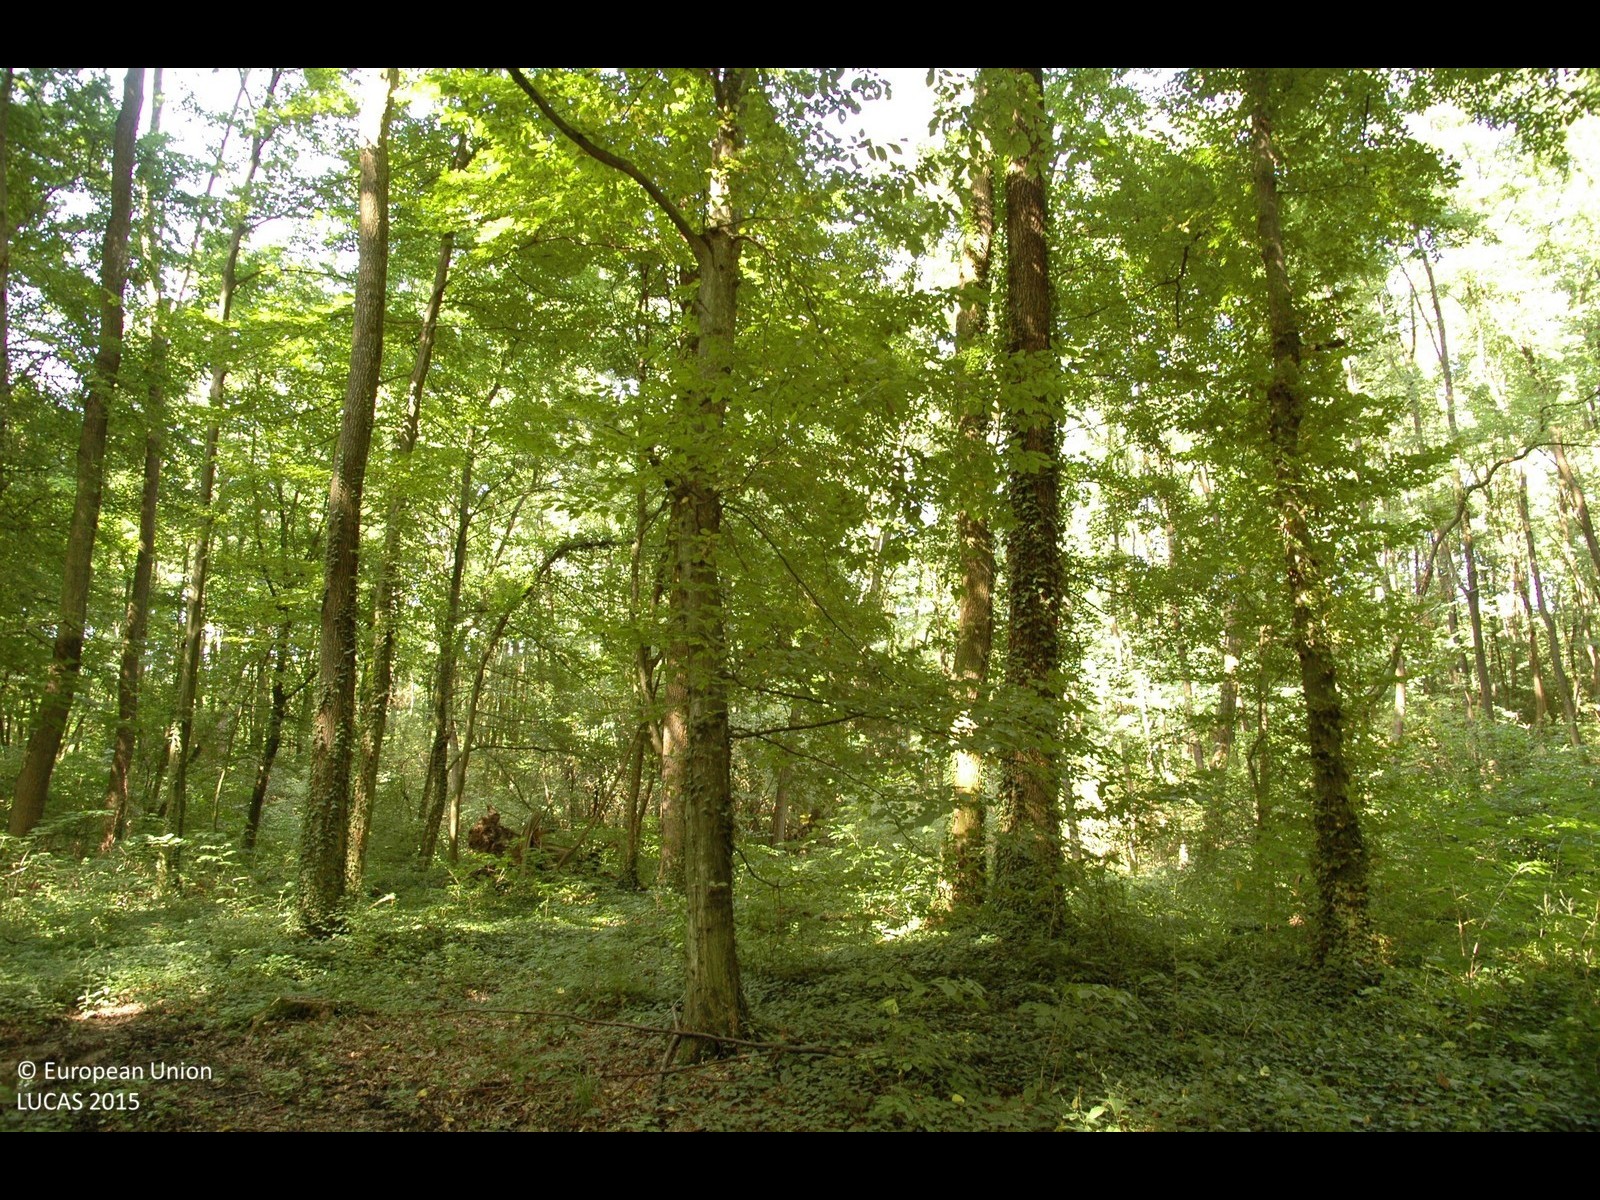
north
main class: Woodland
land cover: Broadleaved woodland
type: mesophytic deciduous forest
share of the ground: > 75 %
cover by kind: broadleaved forest trees 100 %
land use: Forestry
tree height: > 5 m
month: August
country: HR
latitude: 46.1479
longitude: 16.8762
